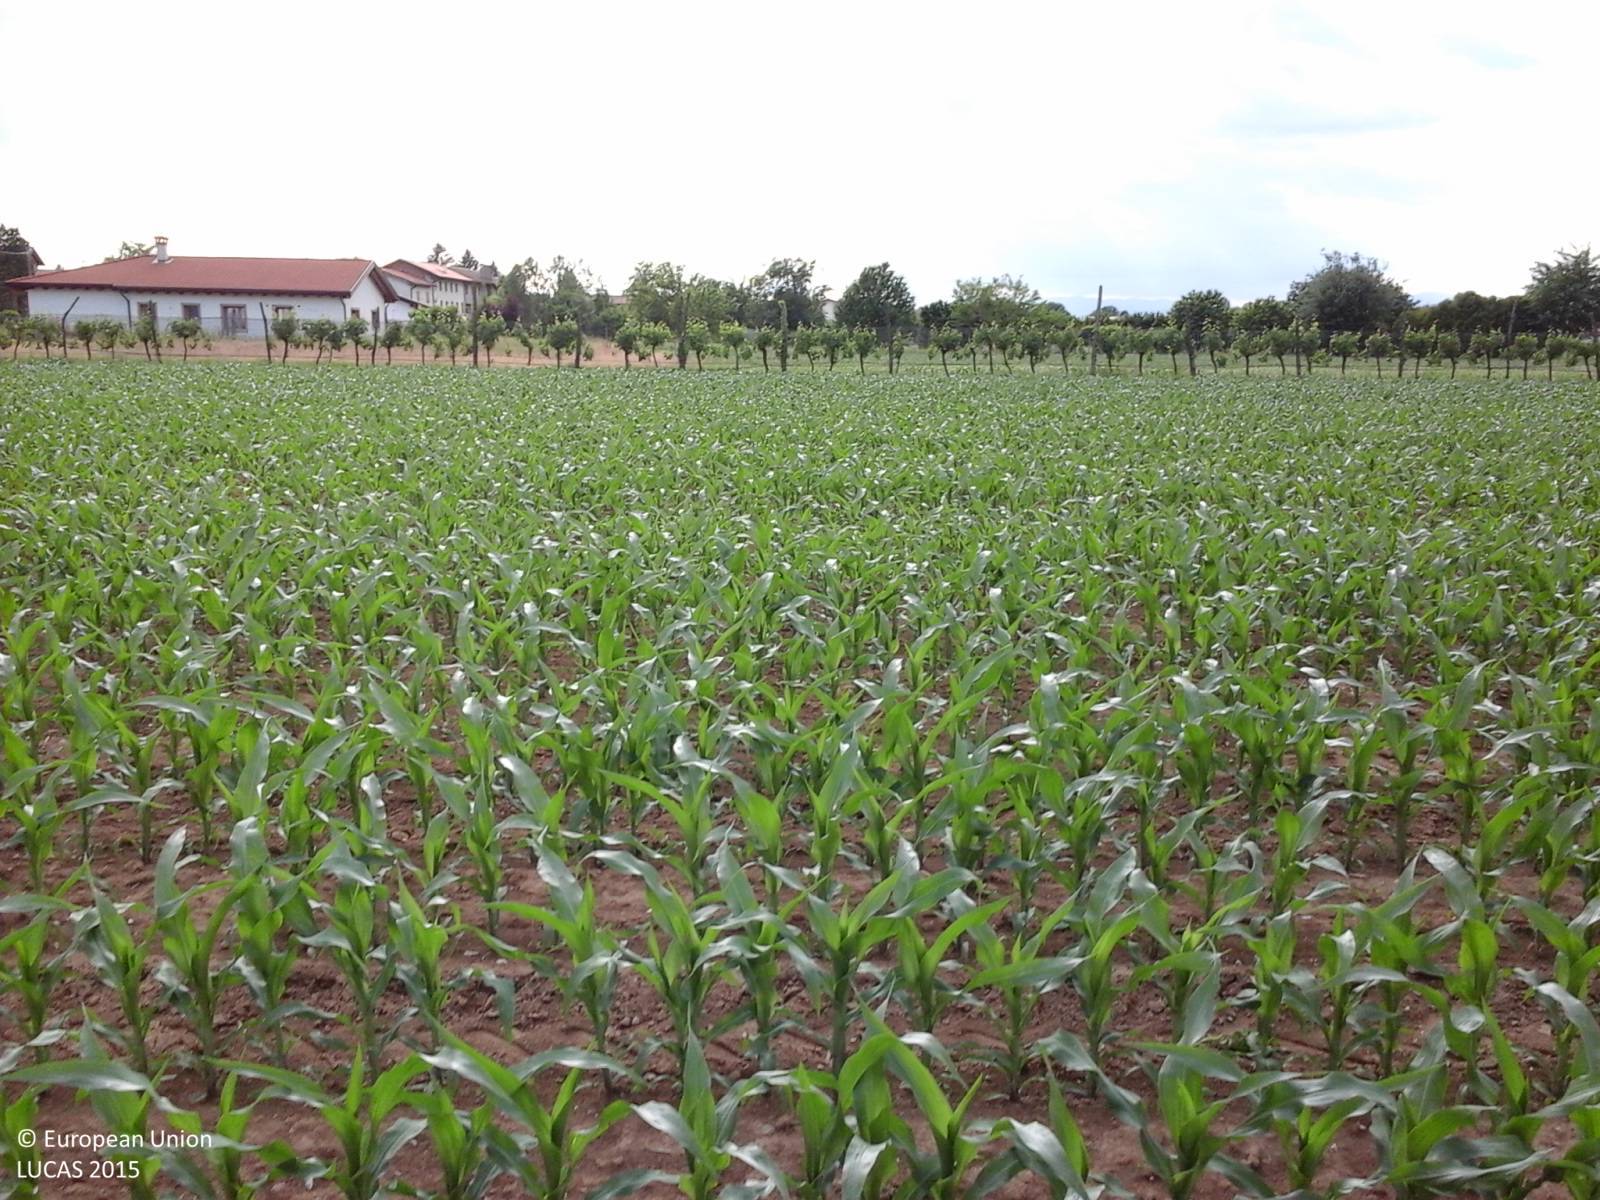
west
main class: Cropland
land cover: Maize
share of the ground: 50 - 75 %
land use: Agriculture (excluding fallow land and kitchen gardens)
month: May
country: IT
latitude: 46.1374
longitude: 13.3232
